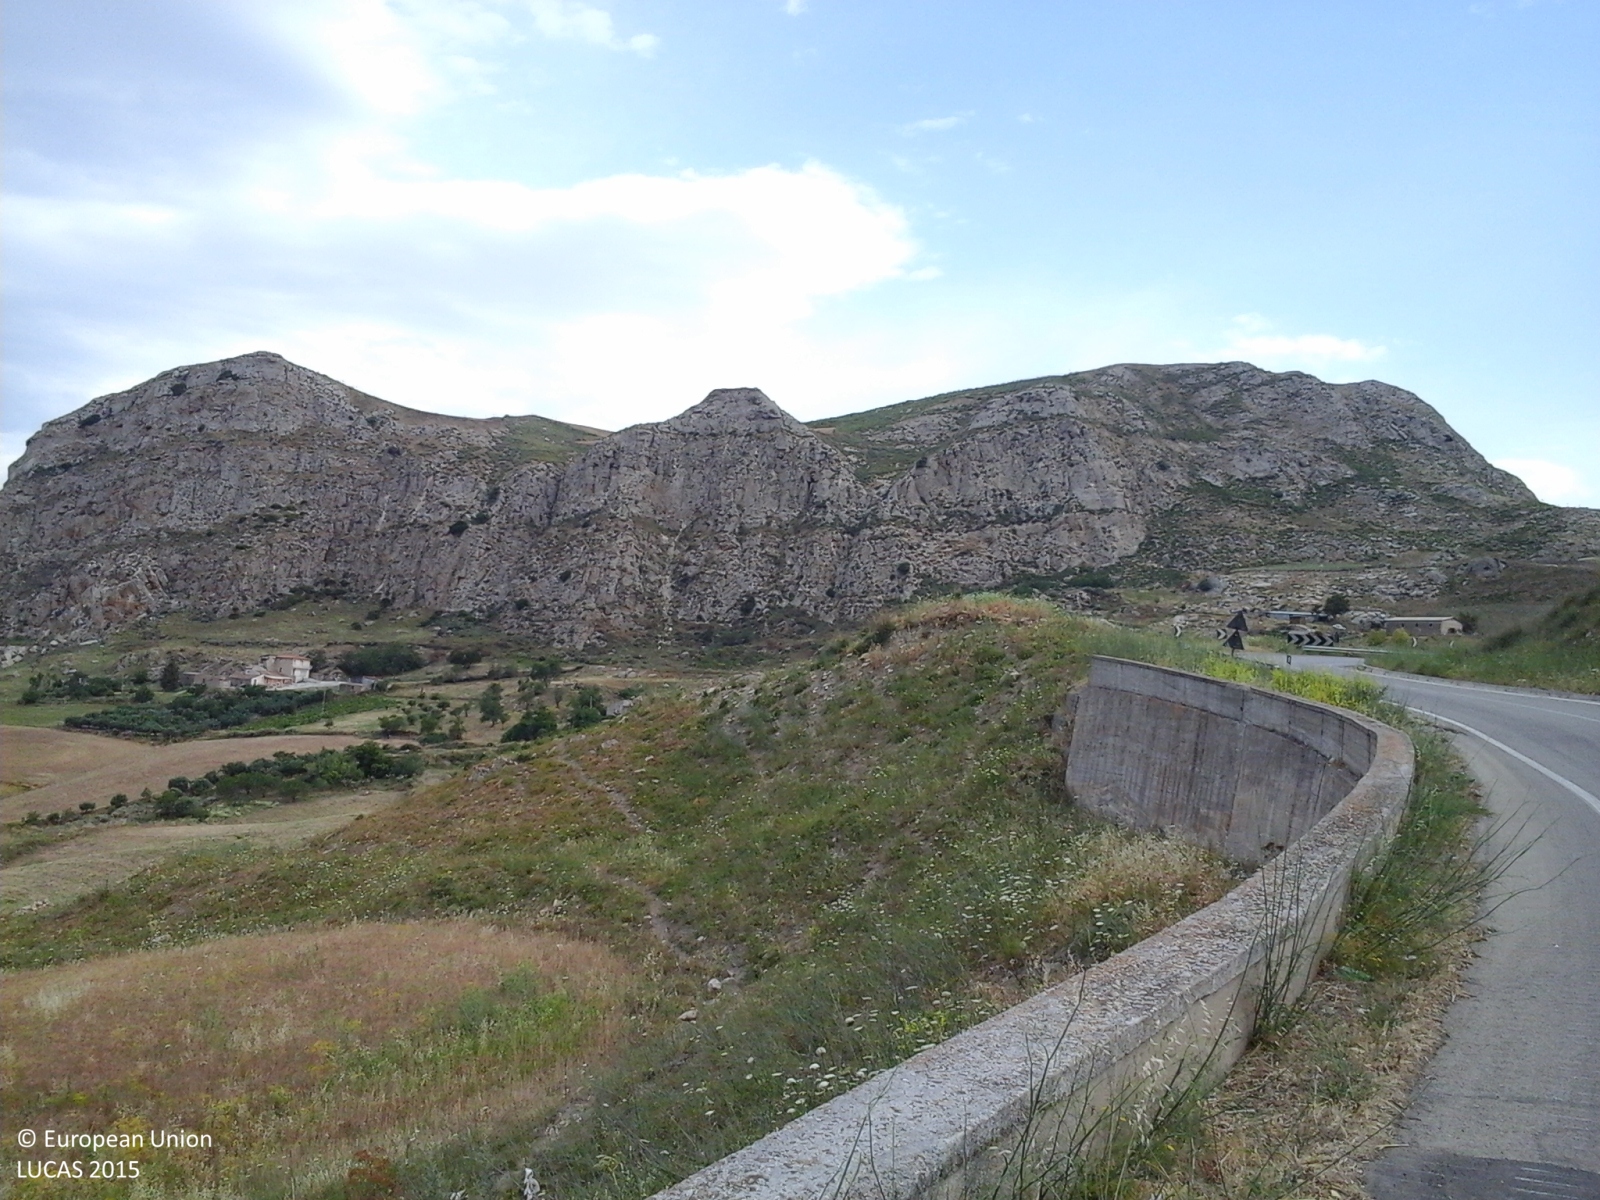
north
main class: Grassland
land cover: Grassland without tree/shrub cover
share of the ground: > 75 %
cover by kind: herbaceous plants 100 %
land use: Agriculture (excluding fallow land and kitchen gardens)
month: June
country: IT
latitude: 37.8775
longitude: 13.6461
